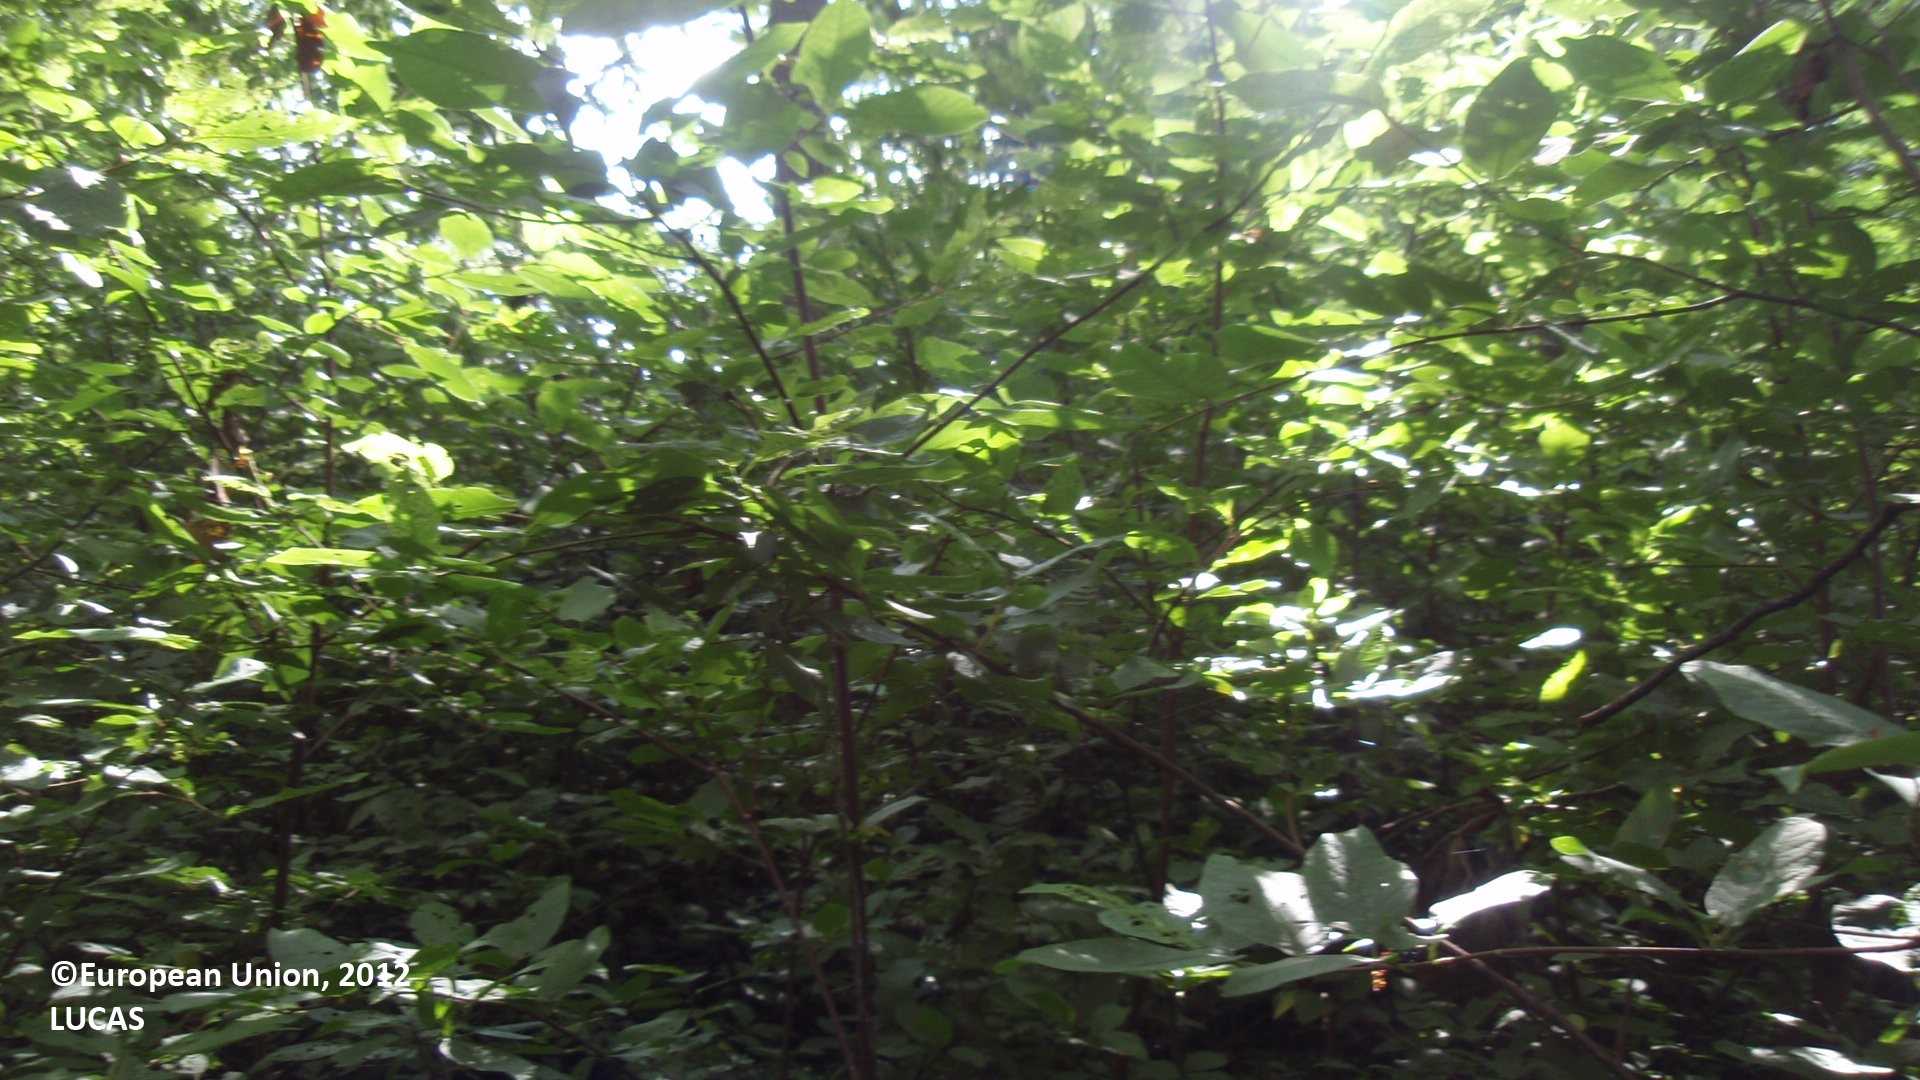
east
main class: Woodland
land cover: Broadleaved woodland
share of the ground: 50 - 75 %
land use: Forestry
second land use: Amenities, museums, leisure
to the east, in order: Broadleaved woodland; Sand; Grass margins; Paved roads, cycling and walking lanes; Grassland without tree/shrub cover; Shrubland with sparse tree cover; Broadleaved woodland; Grassland with sparse tree/shrub cover; Tracks; Grass margins; Ditches and canals; Temporary grasslands
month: July
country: FI
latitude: 61.2320
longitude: 28.8739
